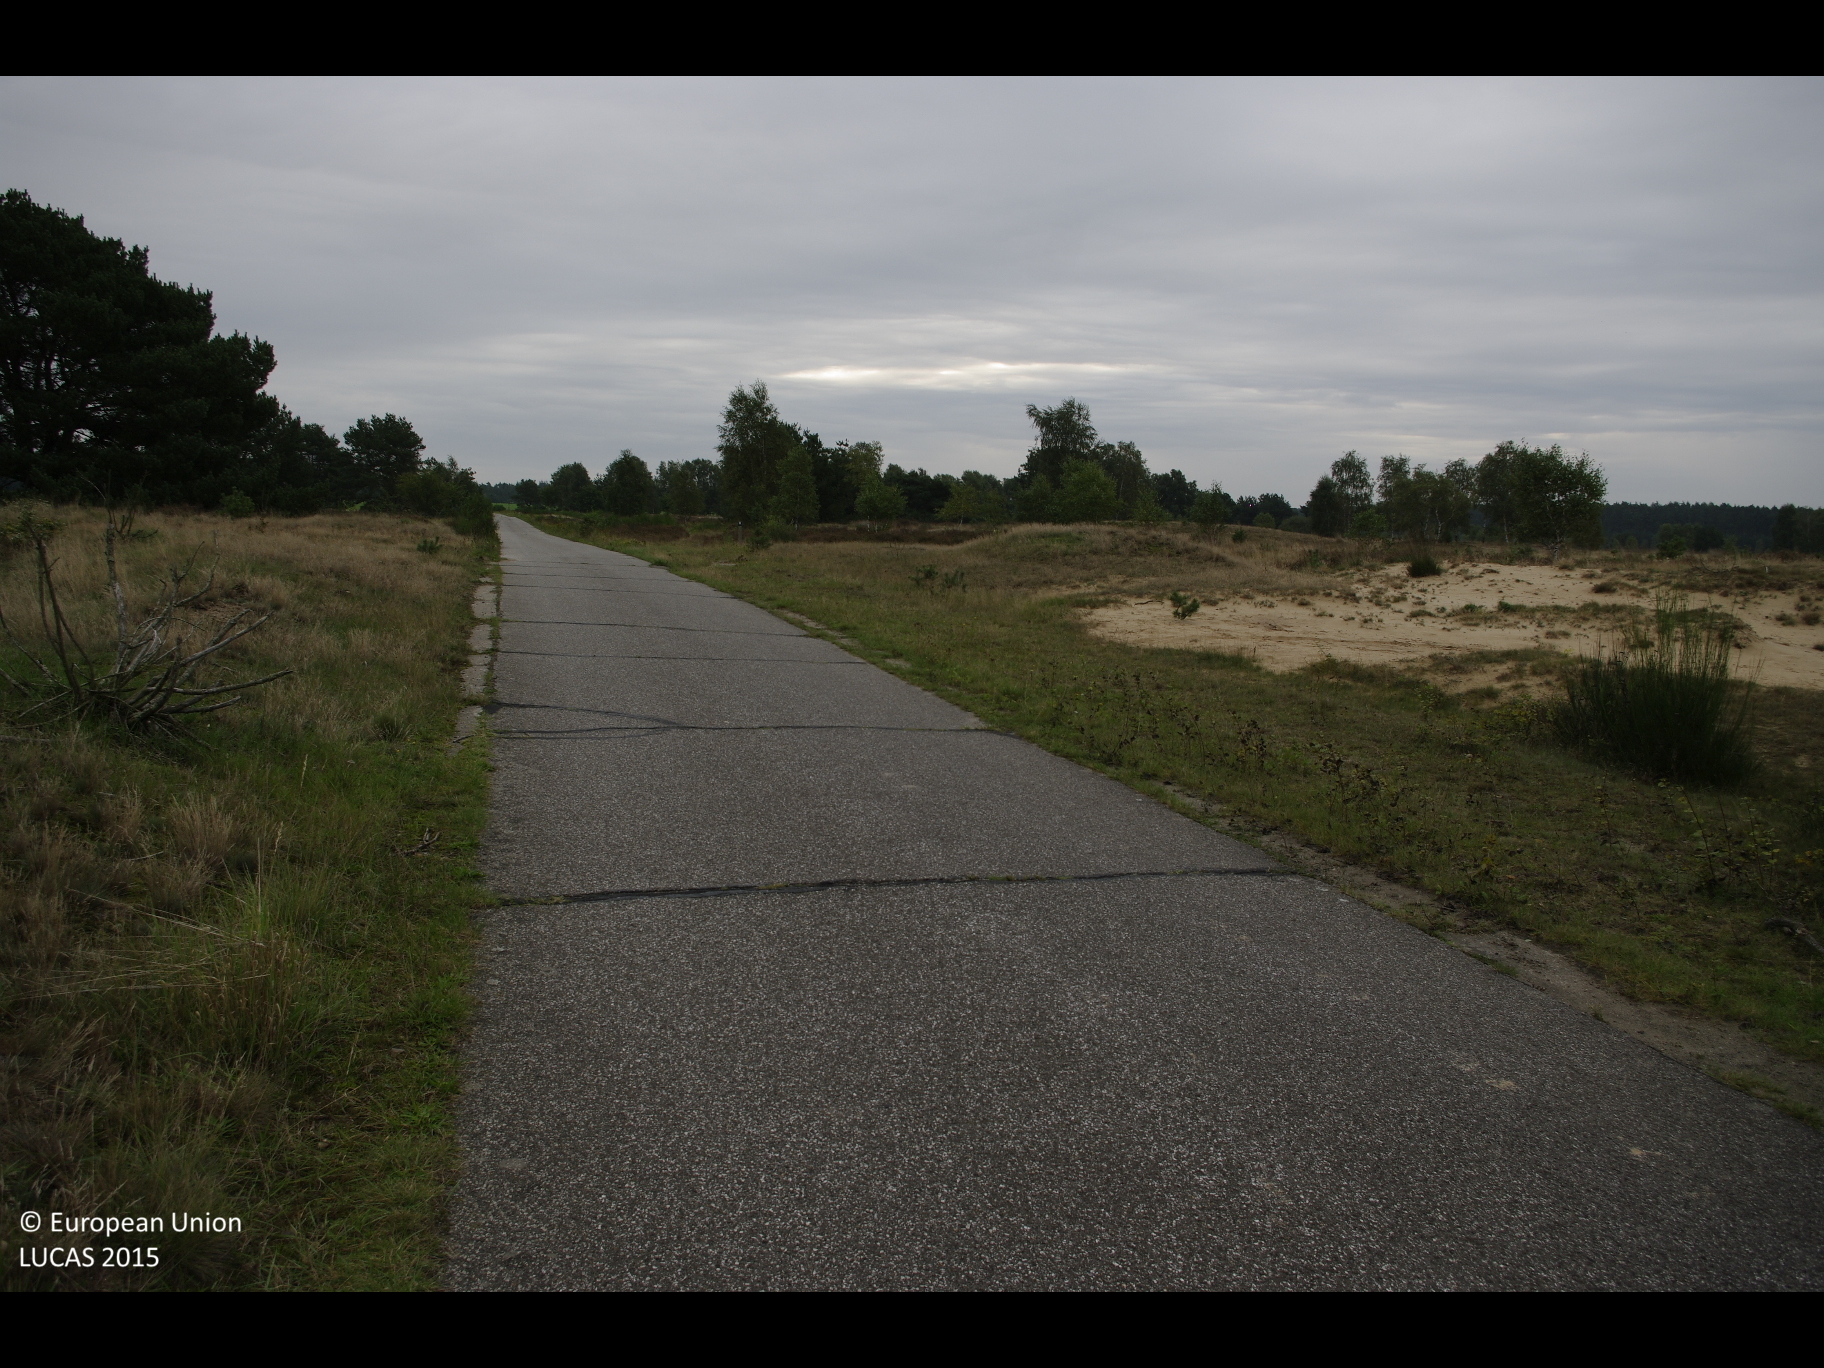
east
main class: Woodland
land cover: Pine dominated coniferous woodland
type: hemiboreal forest and nemoral coniferous forest and mixed broadleaved-coniferous forest
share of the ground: 50 - 75 %
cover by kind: coniferous forest trees 60 %, shrubs 40 %
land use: Forestry
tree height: > 5 m
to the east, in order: Pine dominated coniferous woodland; Shrubland with sparse tree cover; Rape and turnip rape
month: September
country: DE
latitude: 53.1323
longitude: 9.9253
